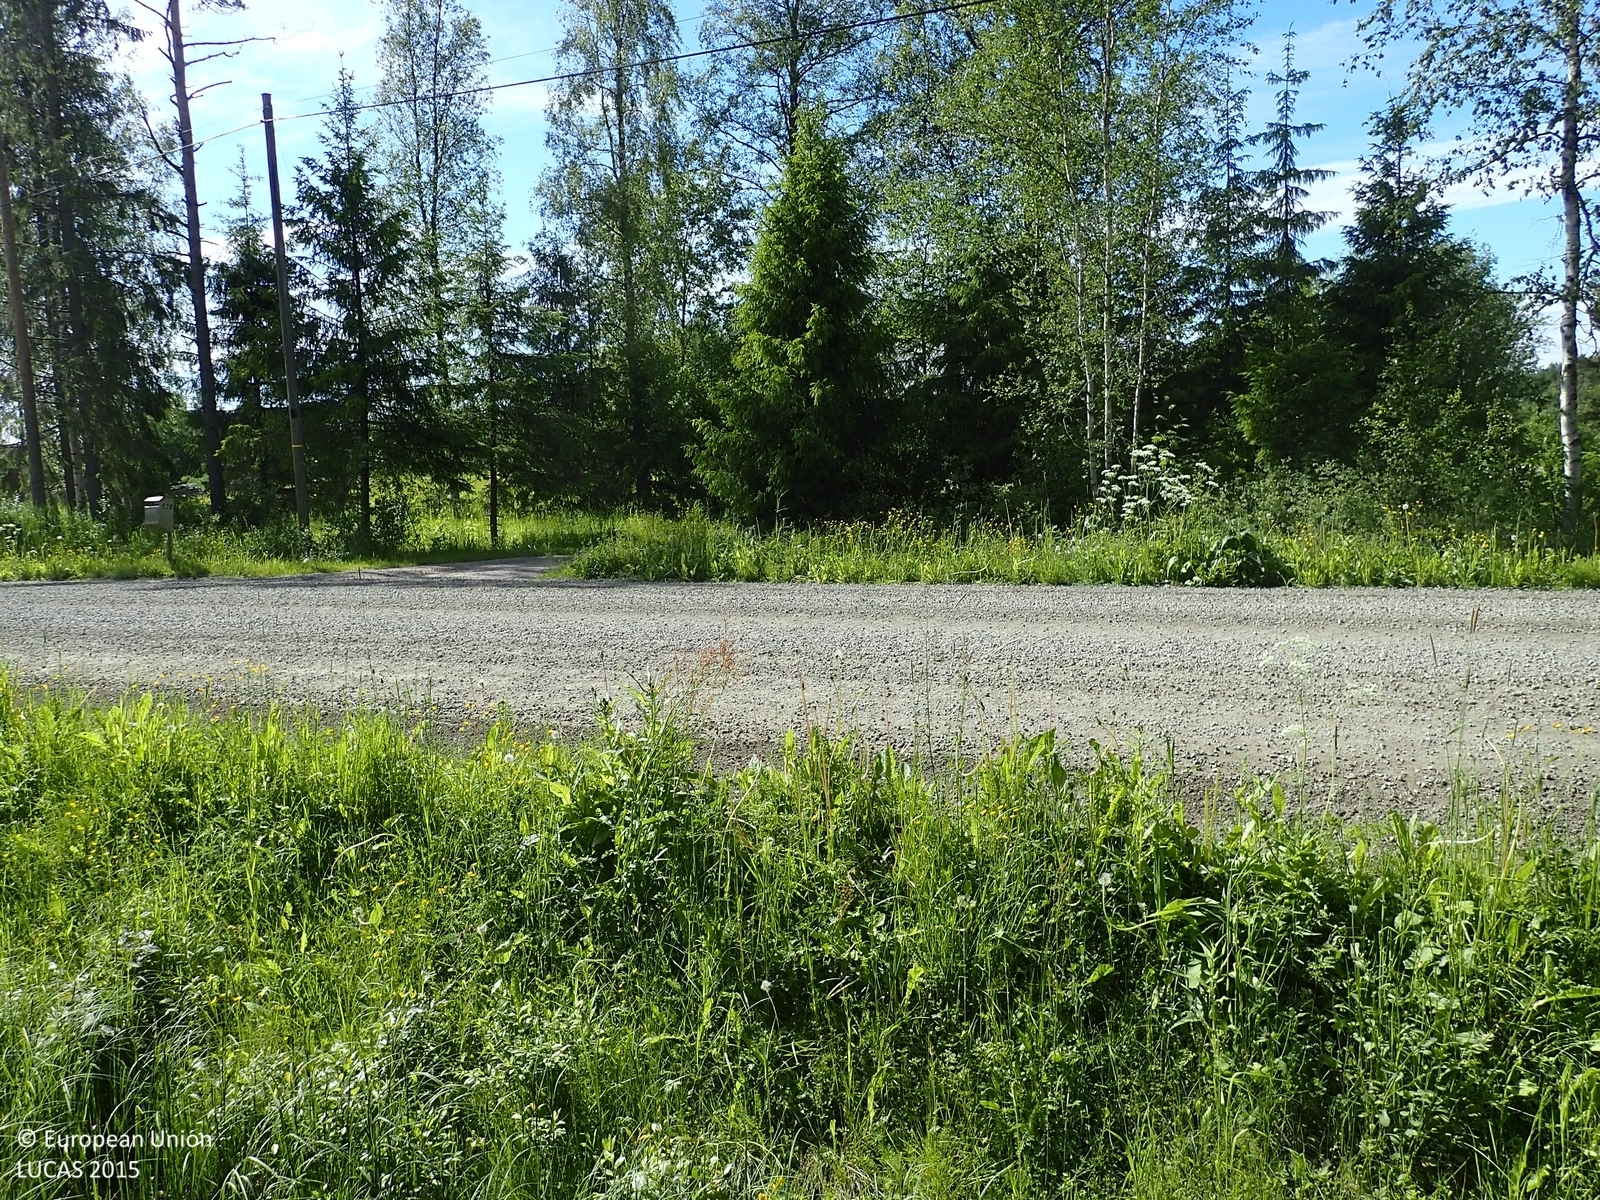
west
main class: Woodland
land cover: Pine dominated coniferous woodland
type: boreal forest
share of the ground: 25 - 50 %
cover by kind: coniferous forest trees 35 %, shrubs 30 %, herbaceous plants 20 %, lichens and mosses 10 %, broadleaved forest trees 5 %
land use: Forestry
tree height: > 5 m
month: June
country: FI
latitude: 62.4534
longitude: 21.6162
